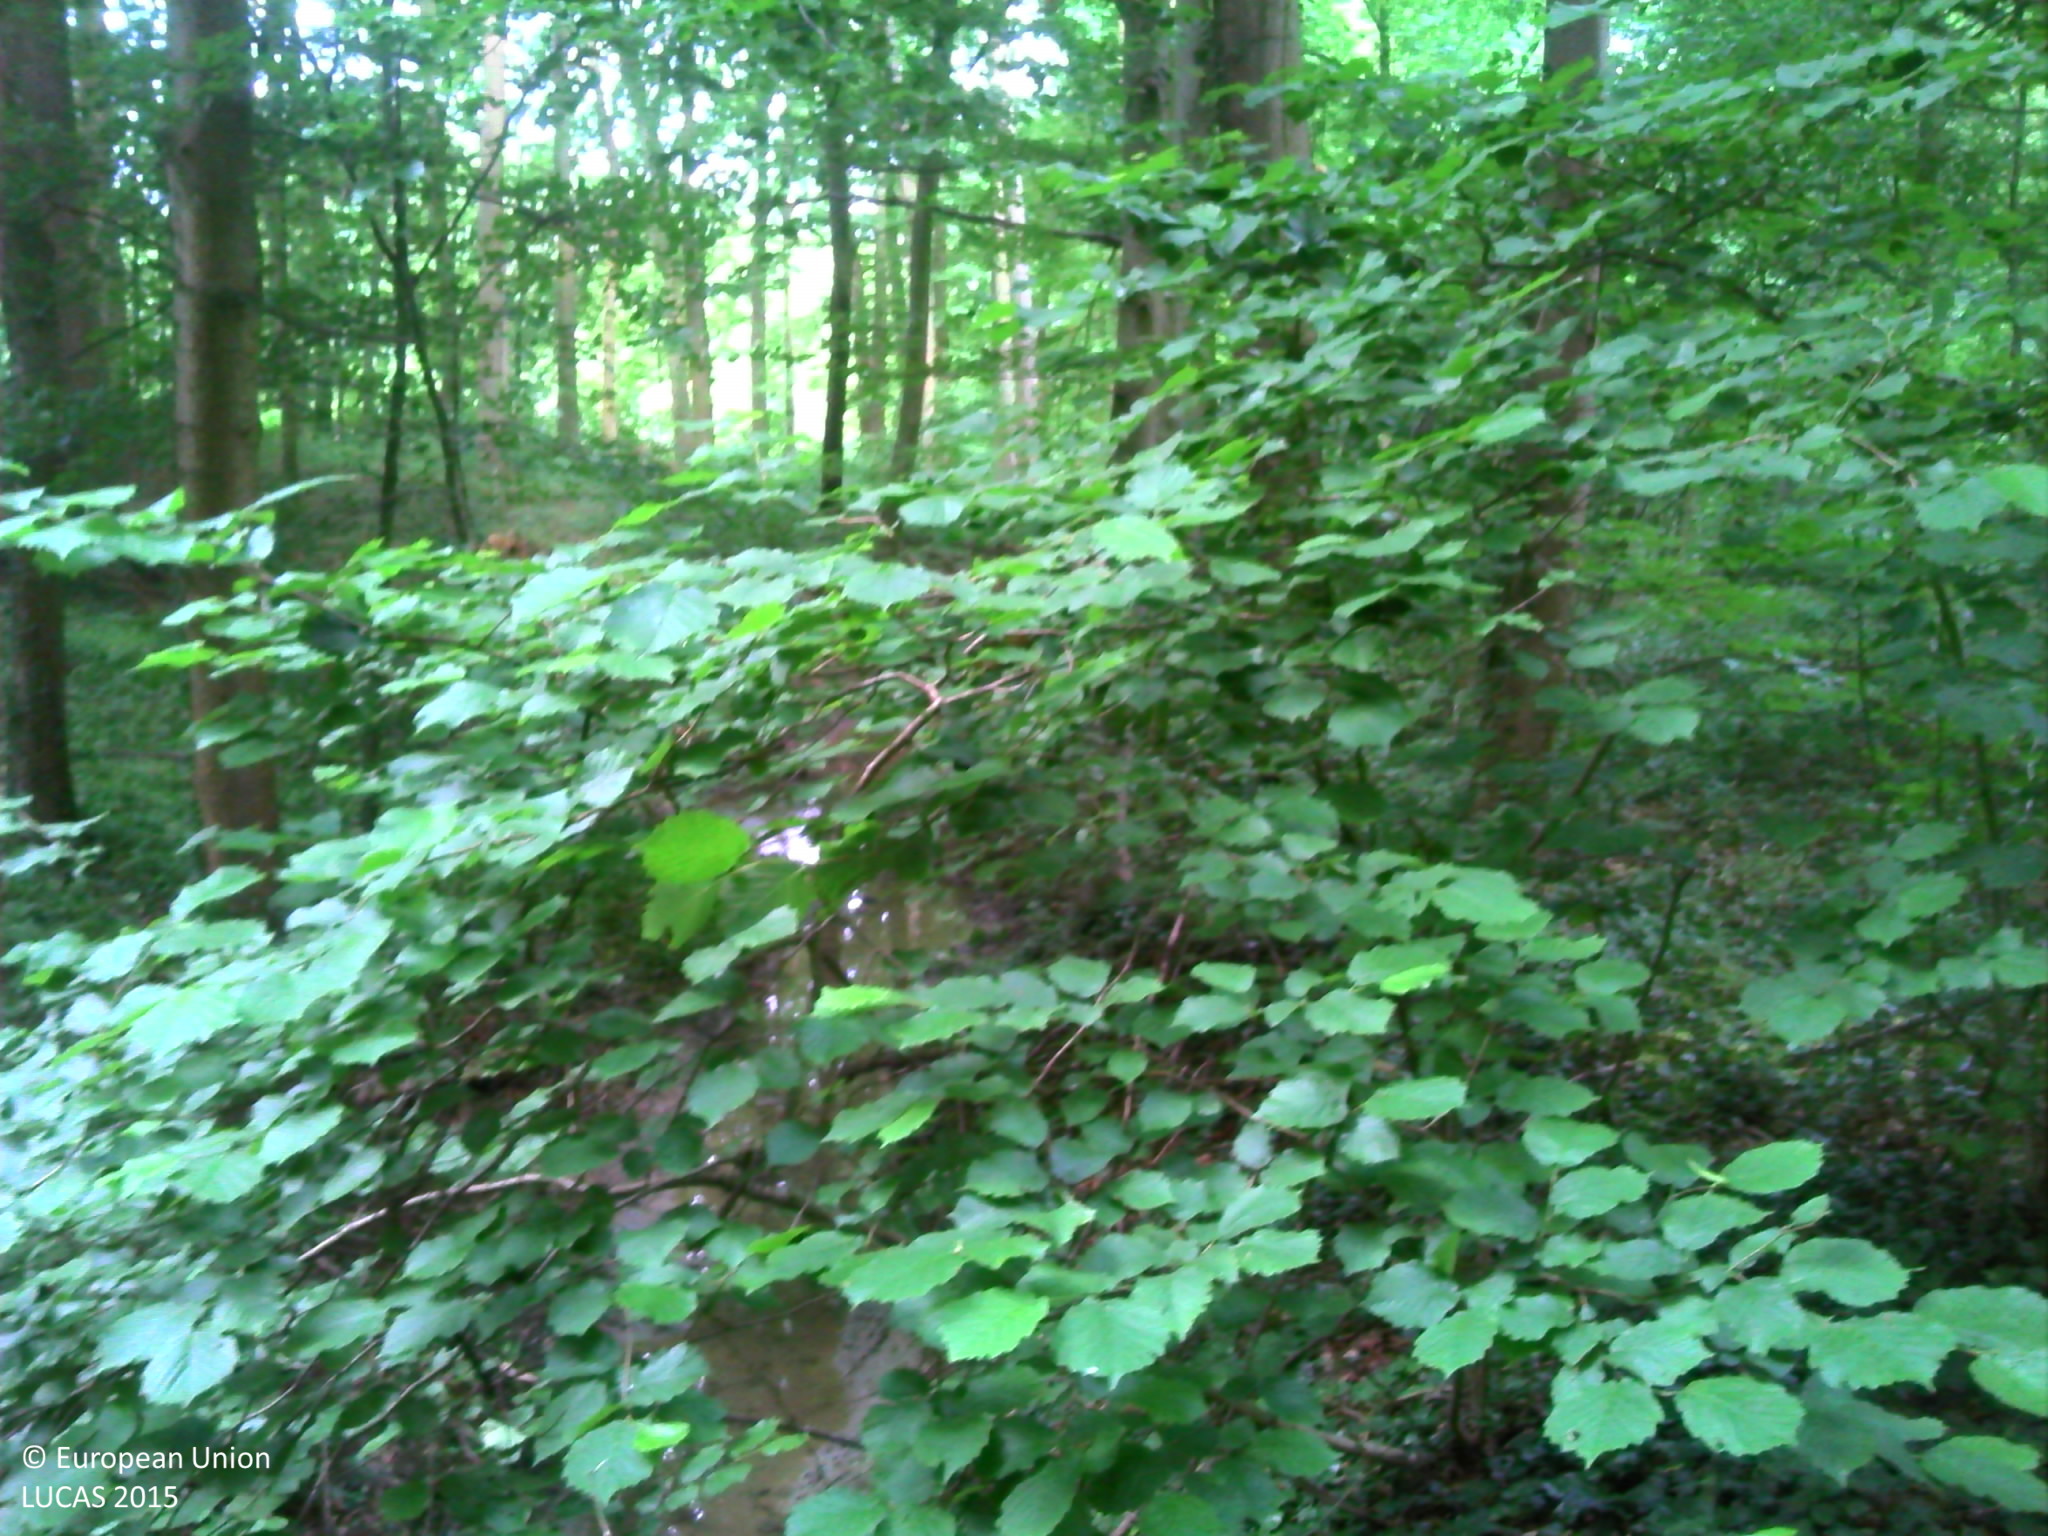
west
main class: Woodland
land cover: Broadleaved woodland
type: beech forest
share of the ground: > 75 %
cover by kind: broadleaved forest trees 95 %, herbaceous plants 5 %
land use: Forestry
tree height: > 5 m
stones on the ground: < 10 %
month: June
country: FR
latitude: 47.6162
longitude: 7.3806
